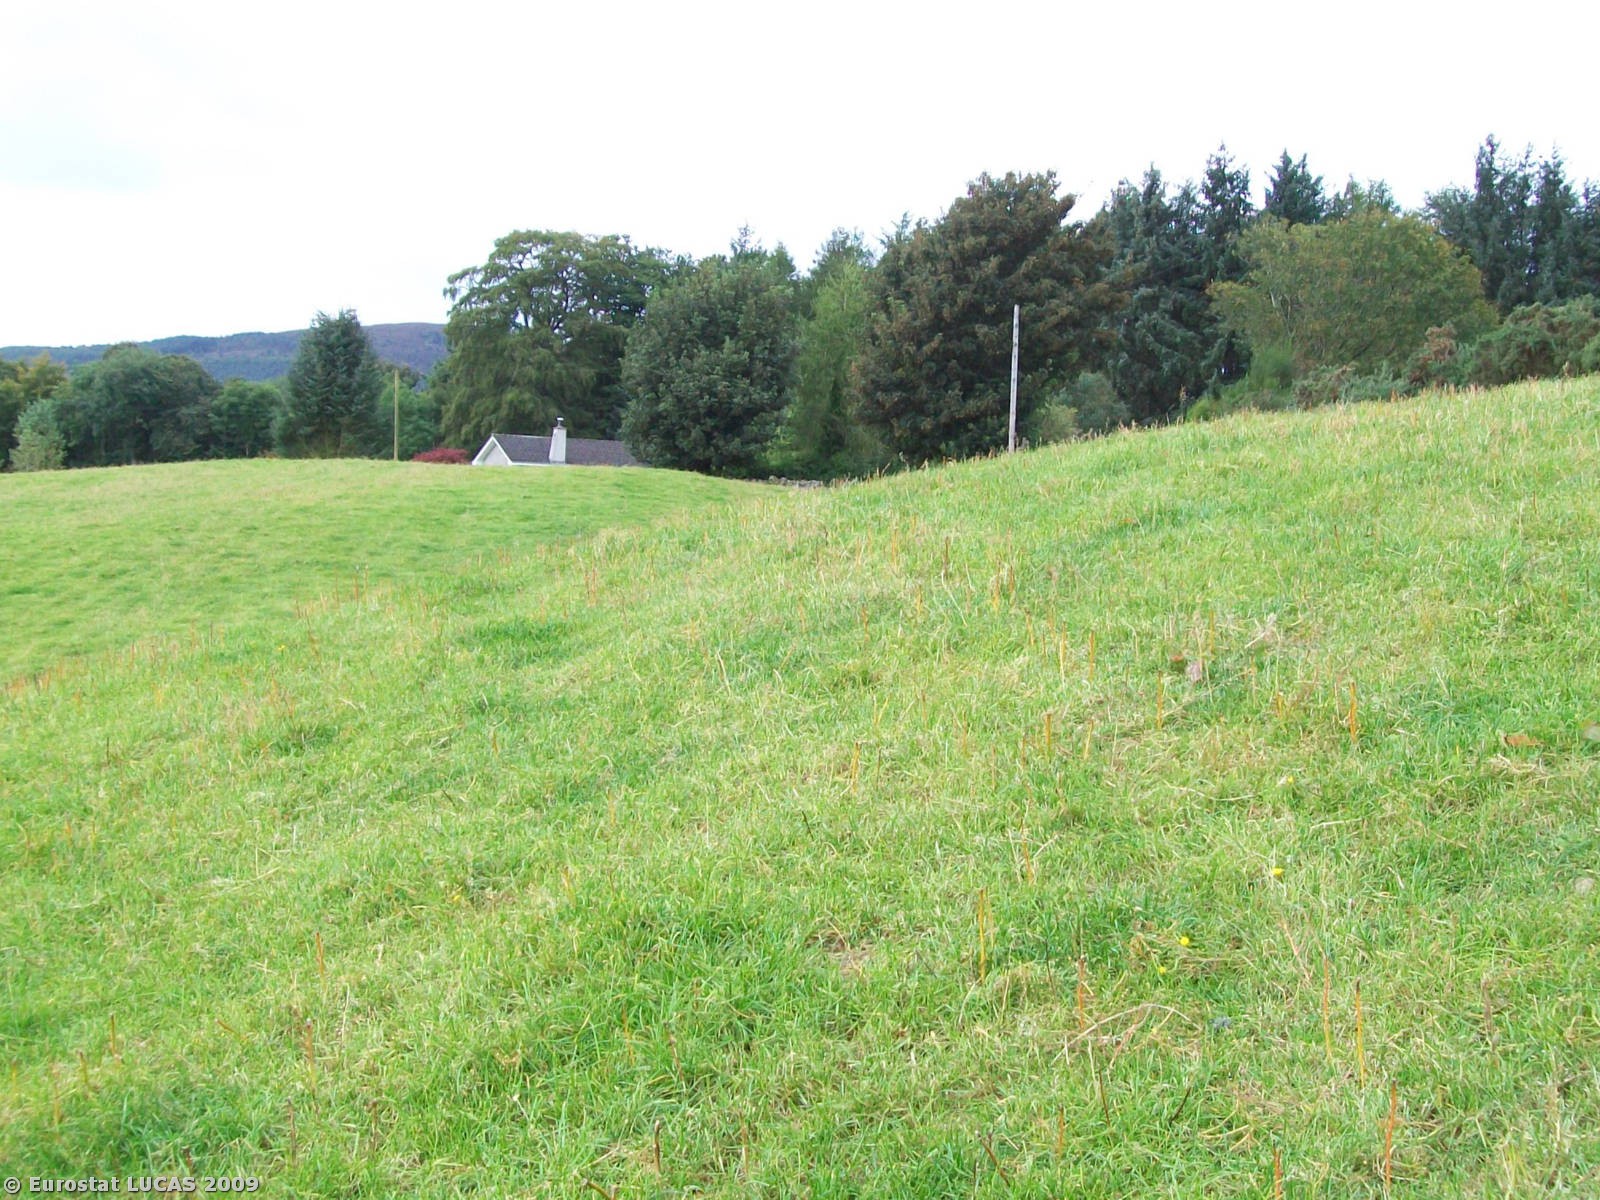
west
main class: Grassland
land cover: Grassland without tree/shrub cover
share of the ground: > 75 %
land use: Agriculture (excluding fallow land and kitchen gardens)
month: September
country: GB
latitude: 57.2500
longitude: -2.5011
